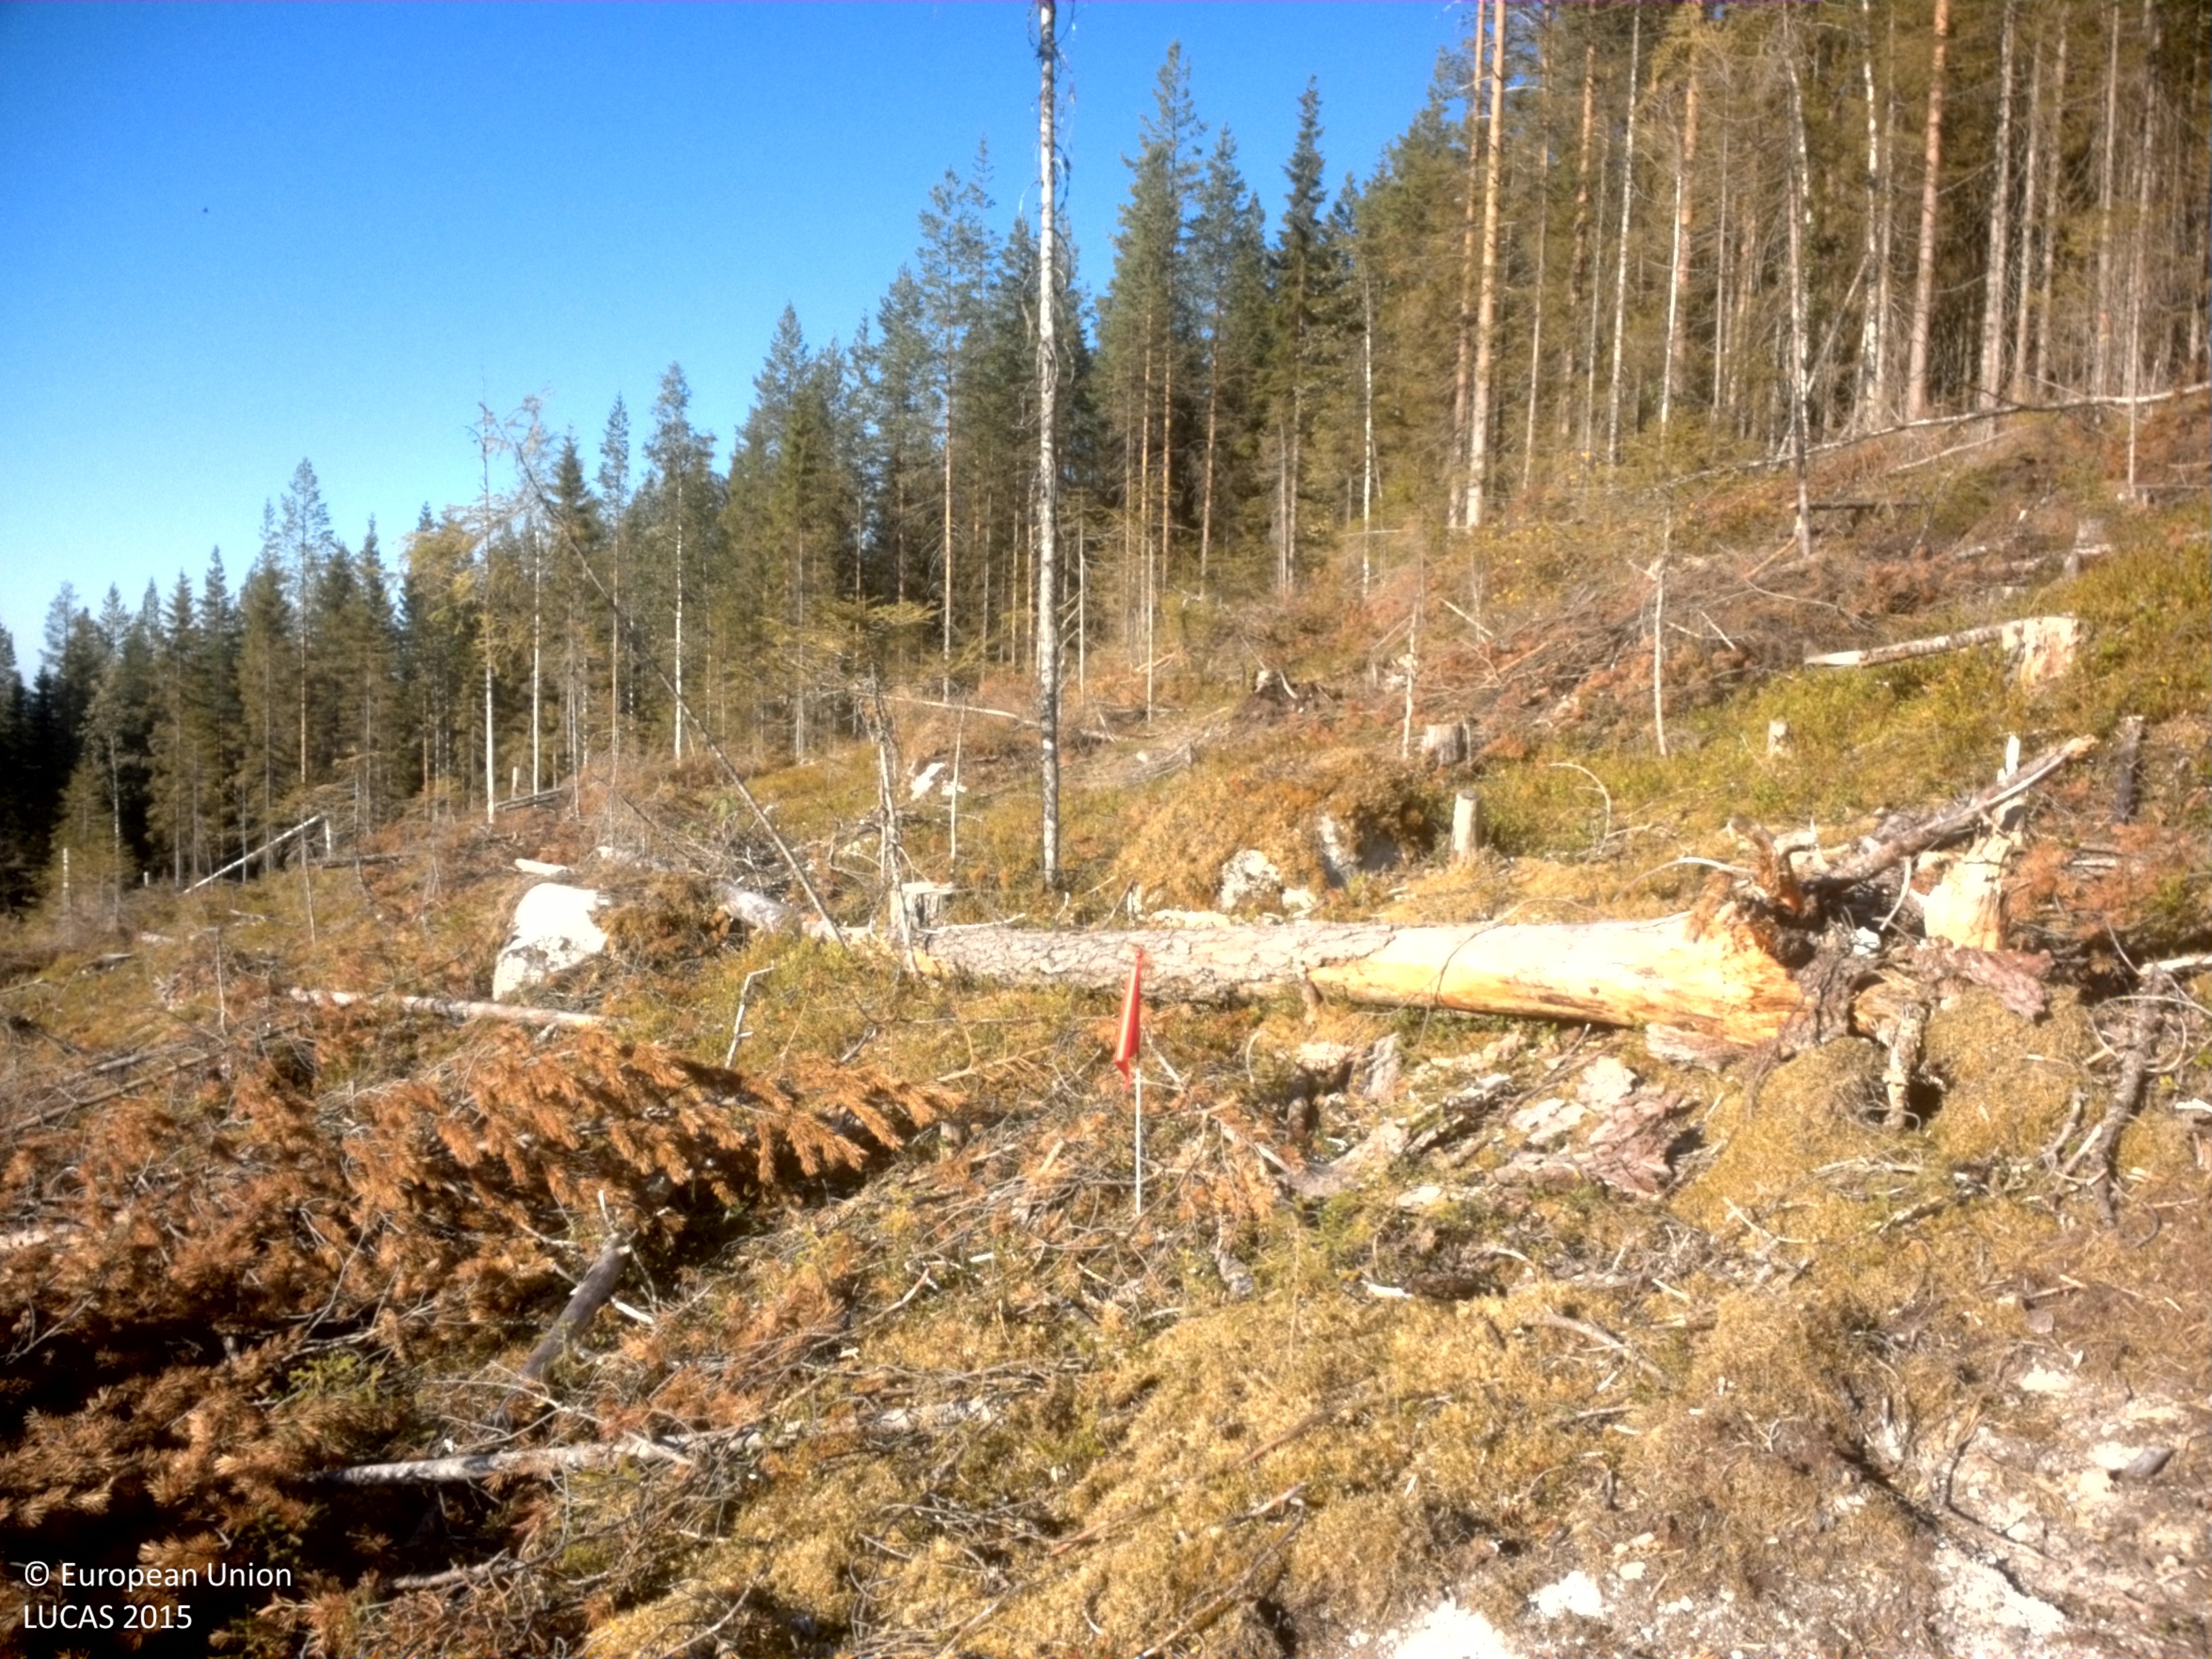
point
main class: Shrubland
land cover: Shrubland with sparse tree cover
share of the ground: > 75 %
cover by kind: shrubs 85 %, lichens and mosses 10 %, coniferous forest trees 5 %
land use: Forestry
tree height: > 5 m
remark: Clear cut
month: August
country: SE
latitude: 64.6275
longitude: 19.1092
